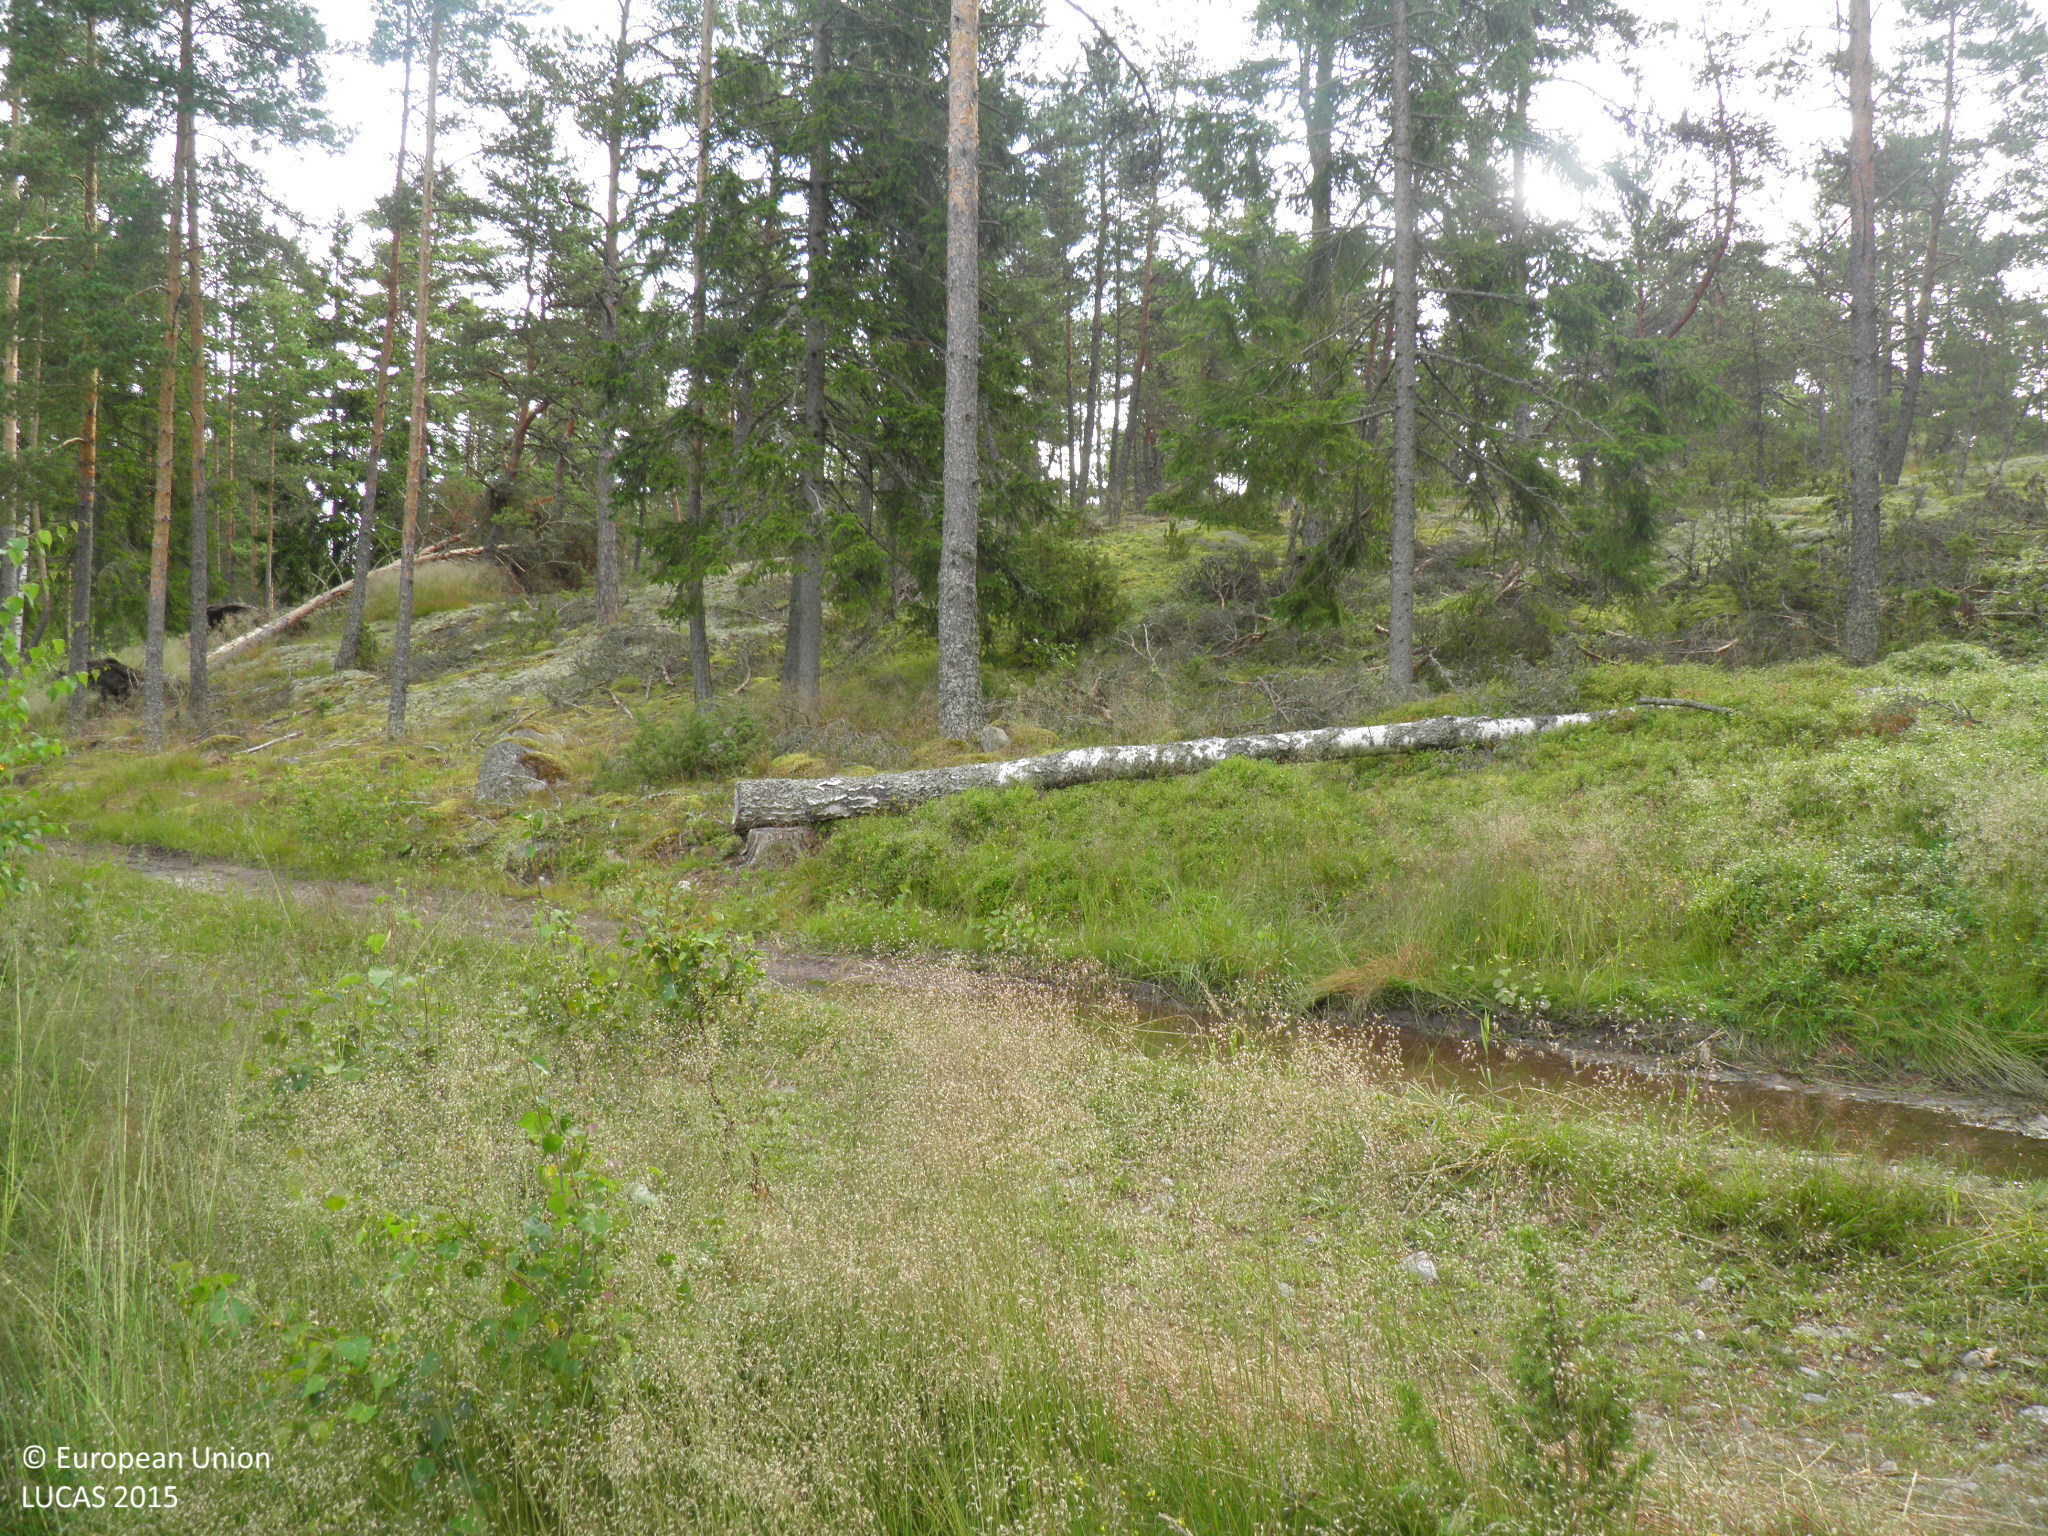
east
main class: Woodland
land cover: Pine dominated coniferous woodland
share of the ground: 50 - 75 %
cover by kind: coniferous forest trees 40 %, shrubs 30 %, broadleaved forest trees 10 %, herbaceous plants 10 %, lichens and mosses 10 %
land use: Forestry
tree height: > 5 m
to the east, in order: Pine dominated coniferous woodland; Tracks; Pine dominated coniferous woodland; Pine dominated mixed woodland
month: July
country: FI
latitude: 60.6835
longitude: 21.3876
